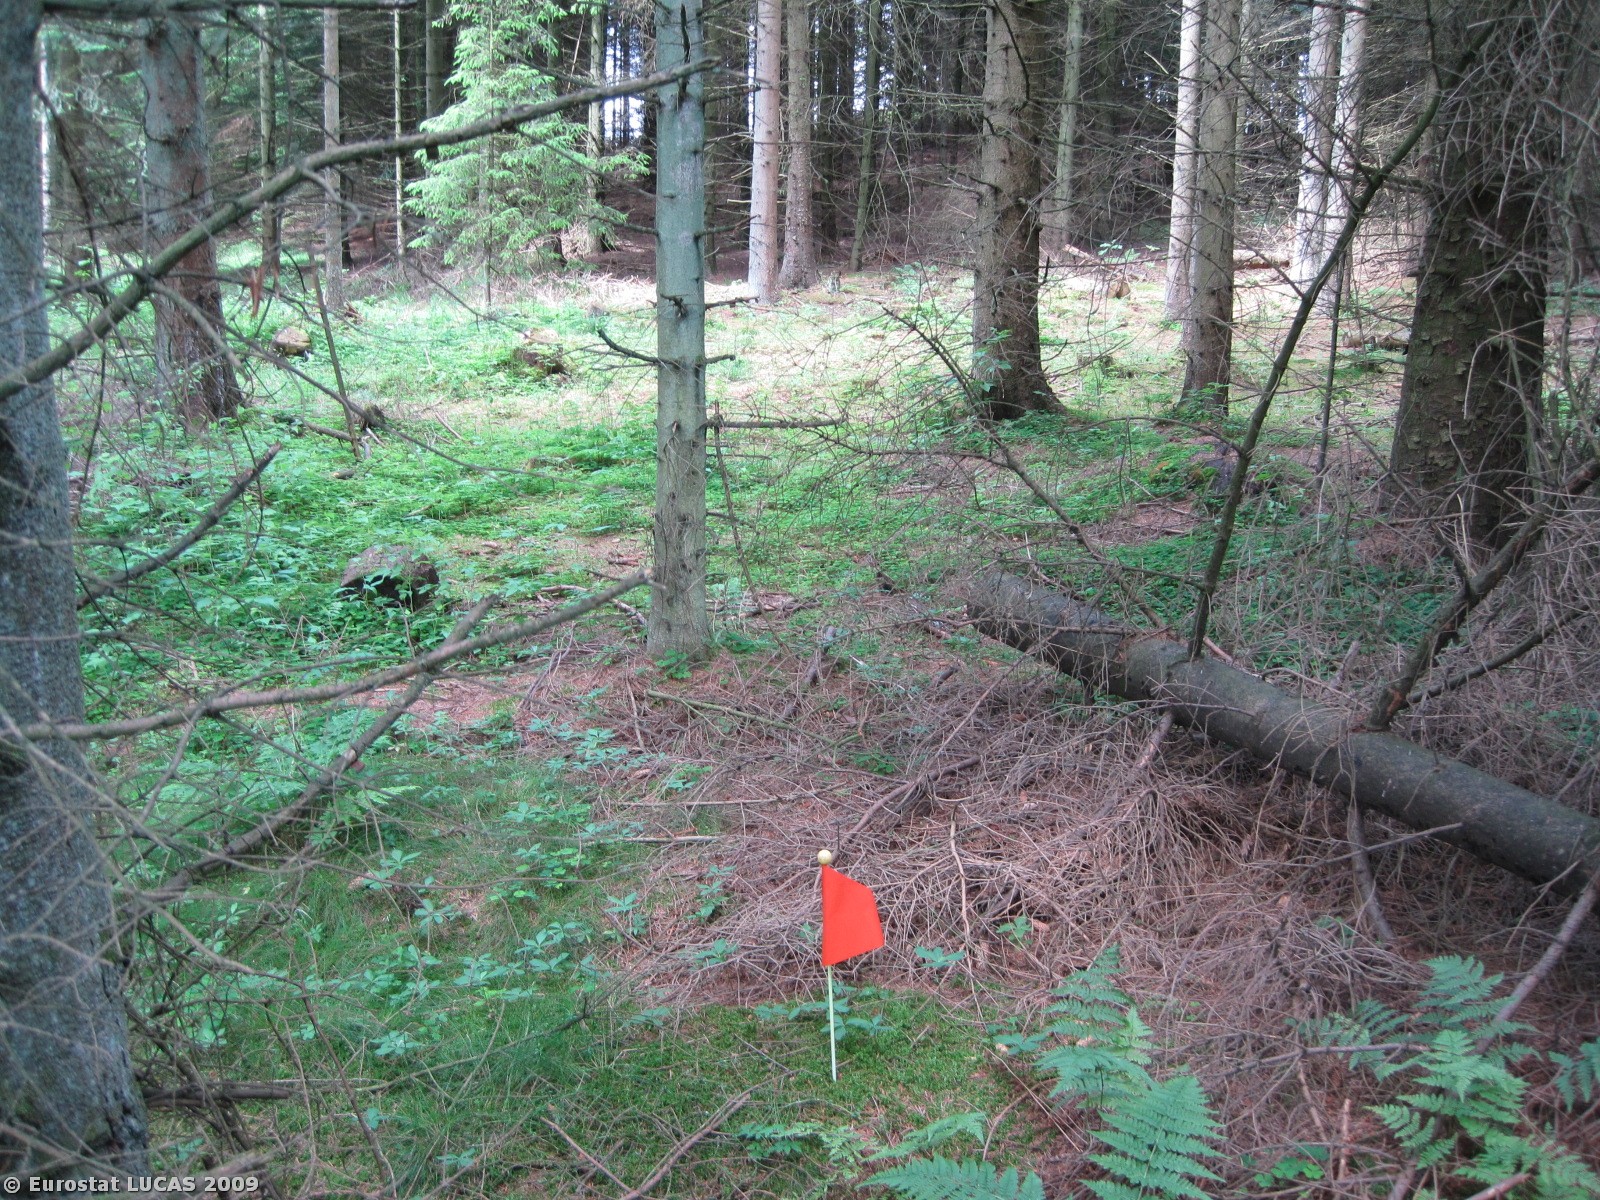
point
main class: Woodland
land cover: Coniferous woodland
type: plantations and self-sown exotic forest
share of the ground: 50 - 75 %
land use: Forestry
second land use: Amenities, museums, leisure
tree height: > 5 m
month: June
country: DK
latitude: 57.1942
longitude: 10.2478
